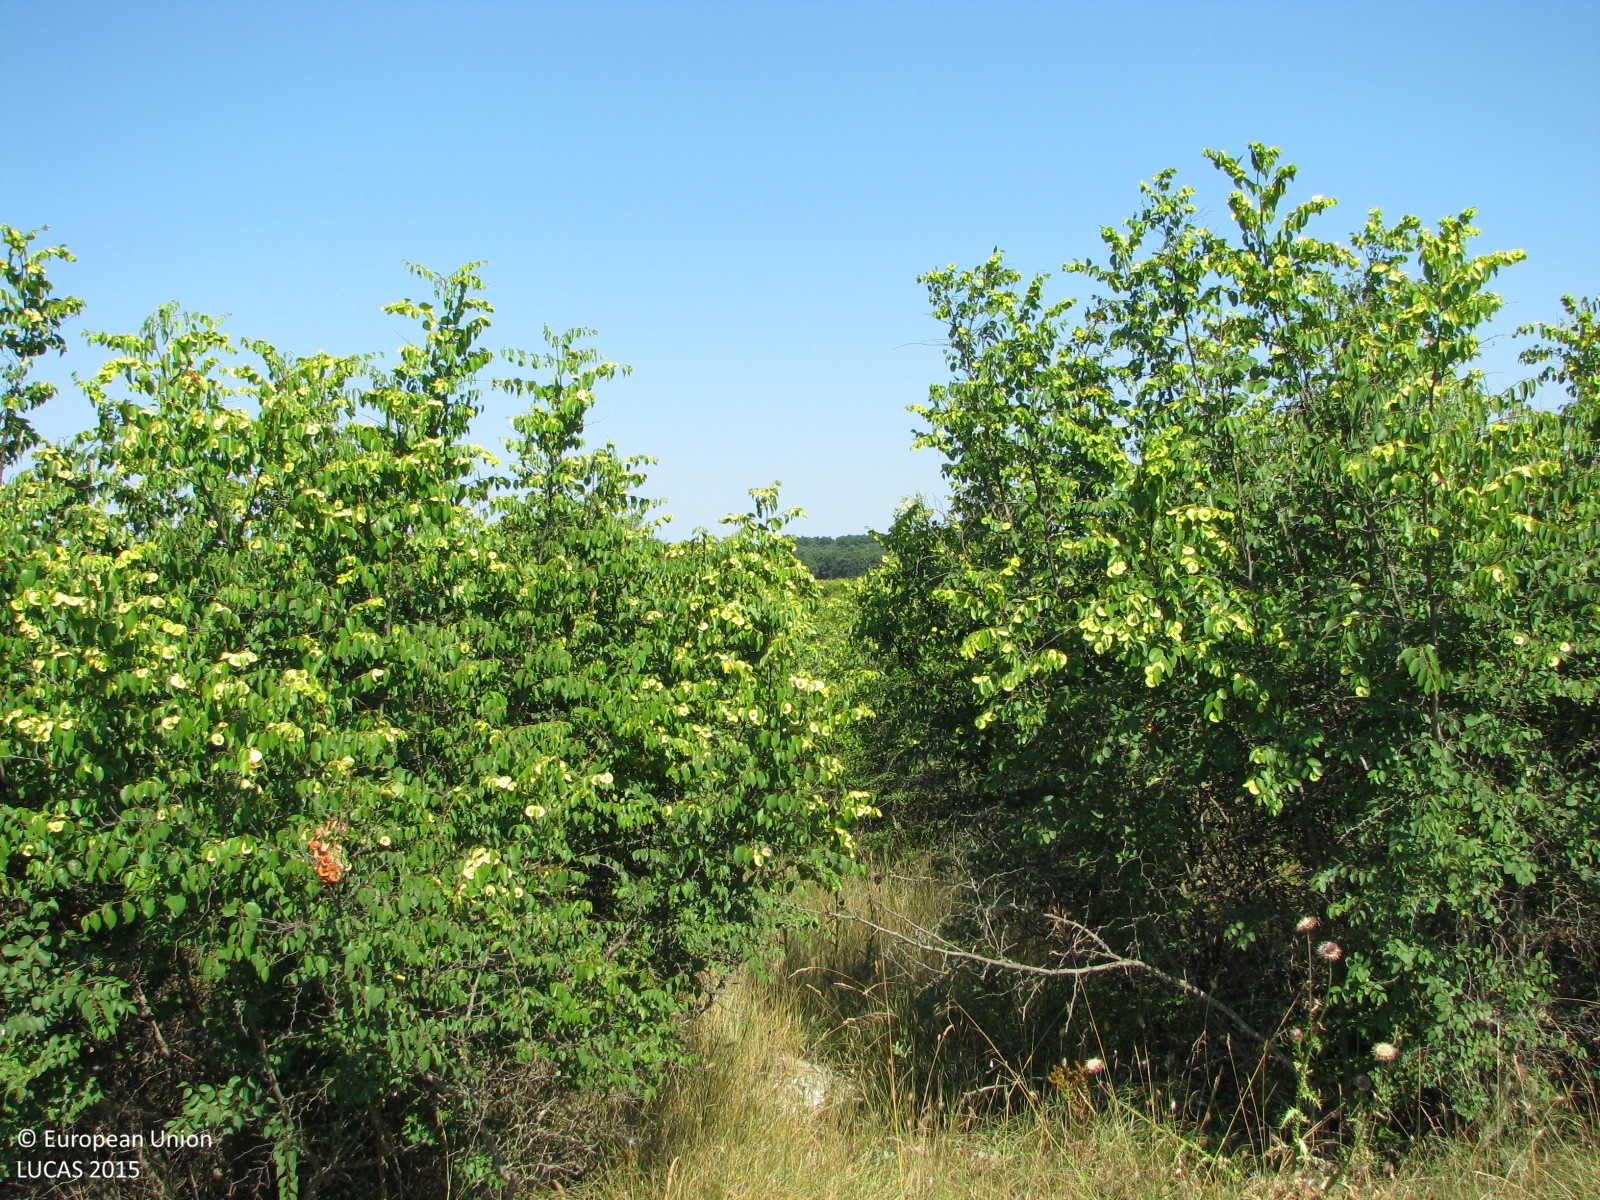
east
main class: Shrubland
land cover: Shrubland without tree cover
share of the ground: > 75 %
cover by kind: herbaceous plants 80 %, shrubs 20 %
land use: Semi-natural and natural areas not in use
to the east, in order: Shrubland without tree cover; Tracks; Shrubland without tree cover; Spontaneously vegetated surfaces
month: July
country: BG
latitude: 42.2766
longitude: 26.8678
